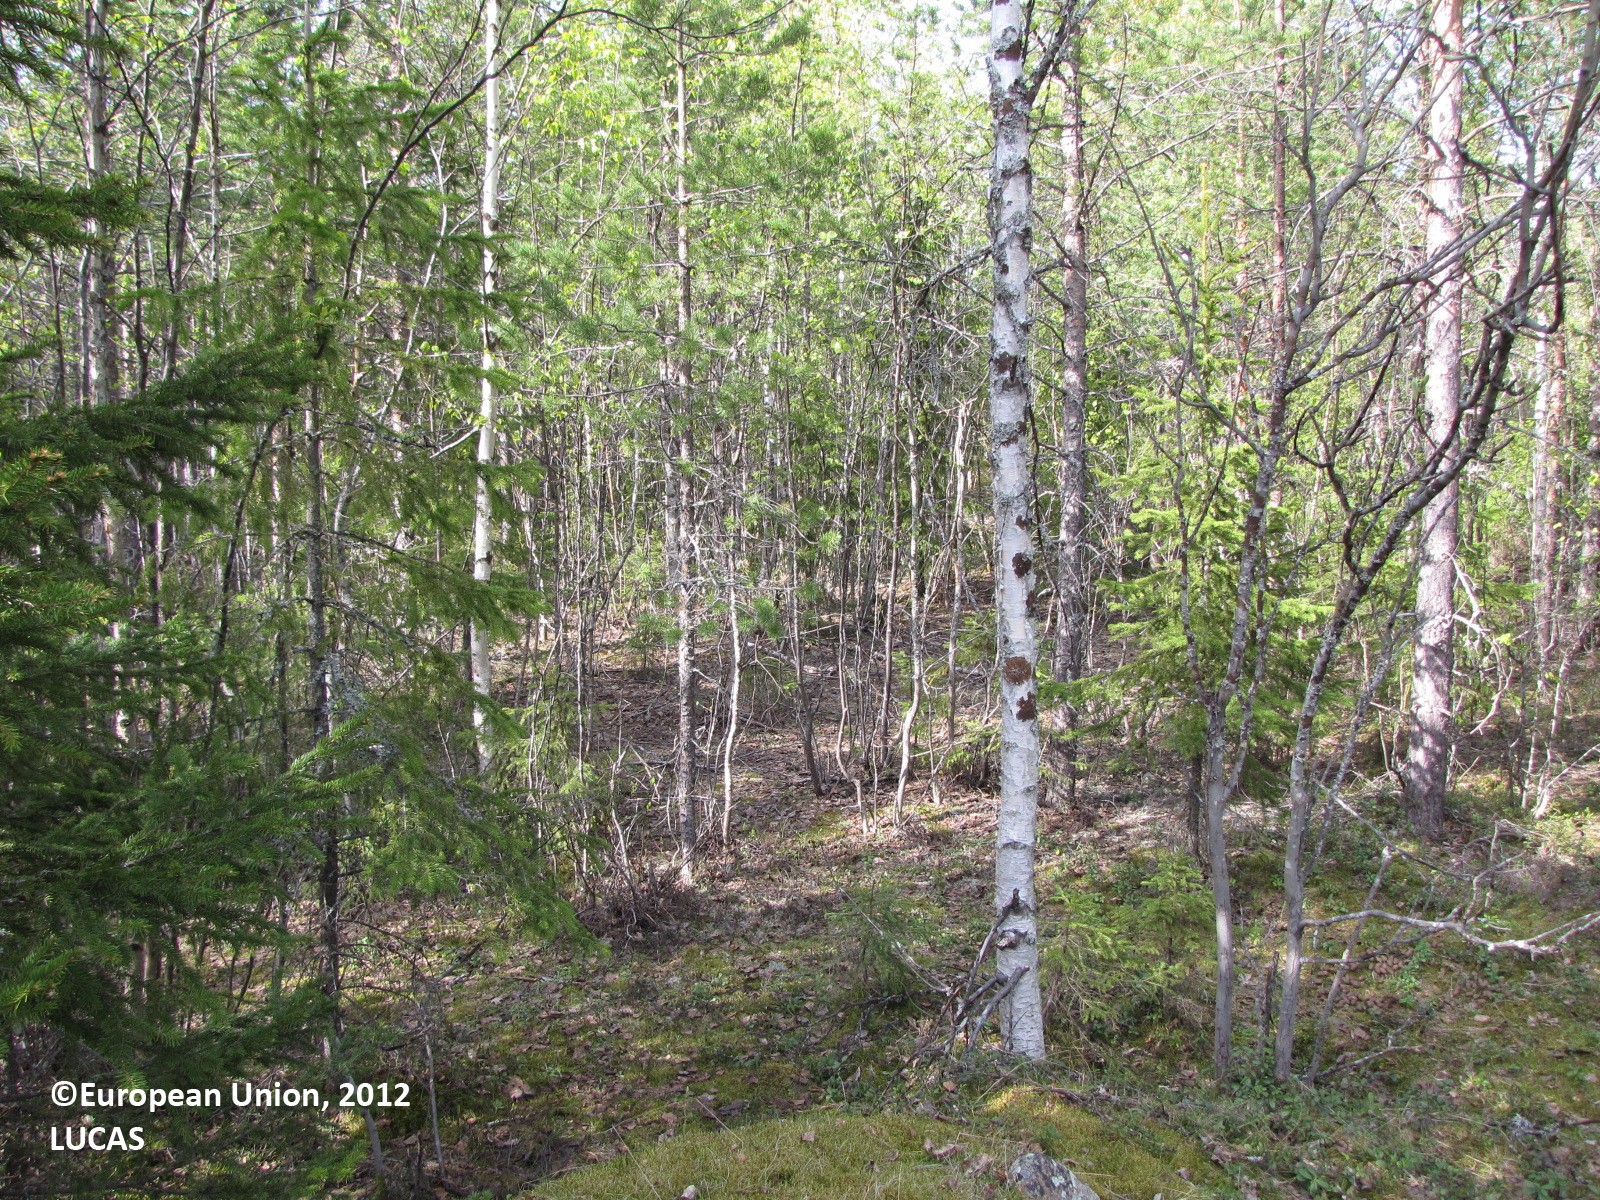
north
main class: Woodland
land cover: Spruce dominated mixed woodland
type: boreal forest
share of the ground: > 75 %
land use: Forestry
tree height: > 5 m
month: May
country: FI
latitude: 65.7959
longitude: 24.6806
